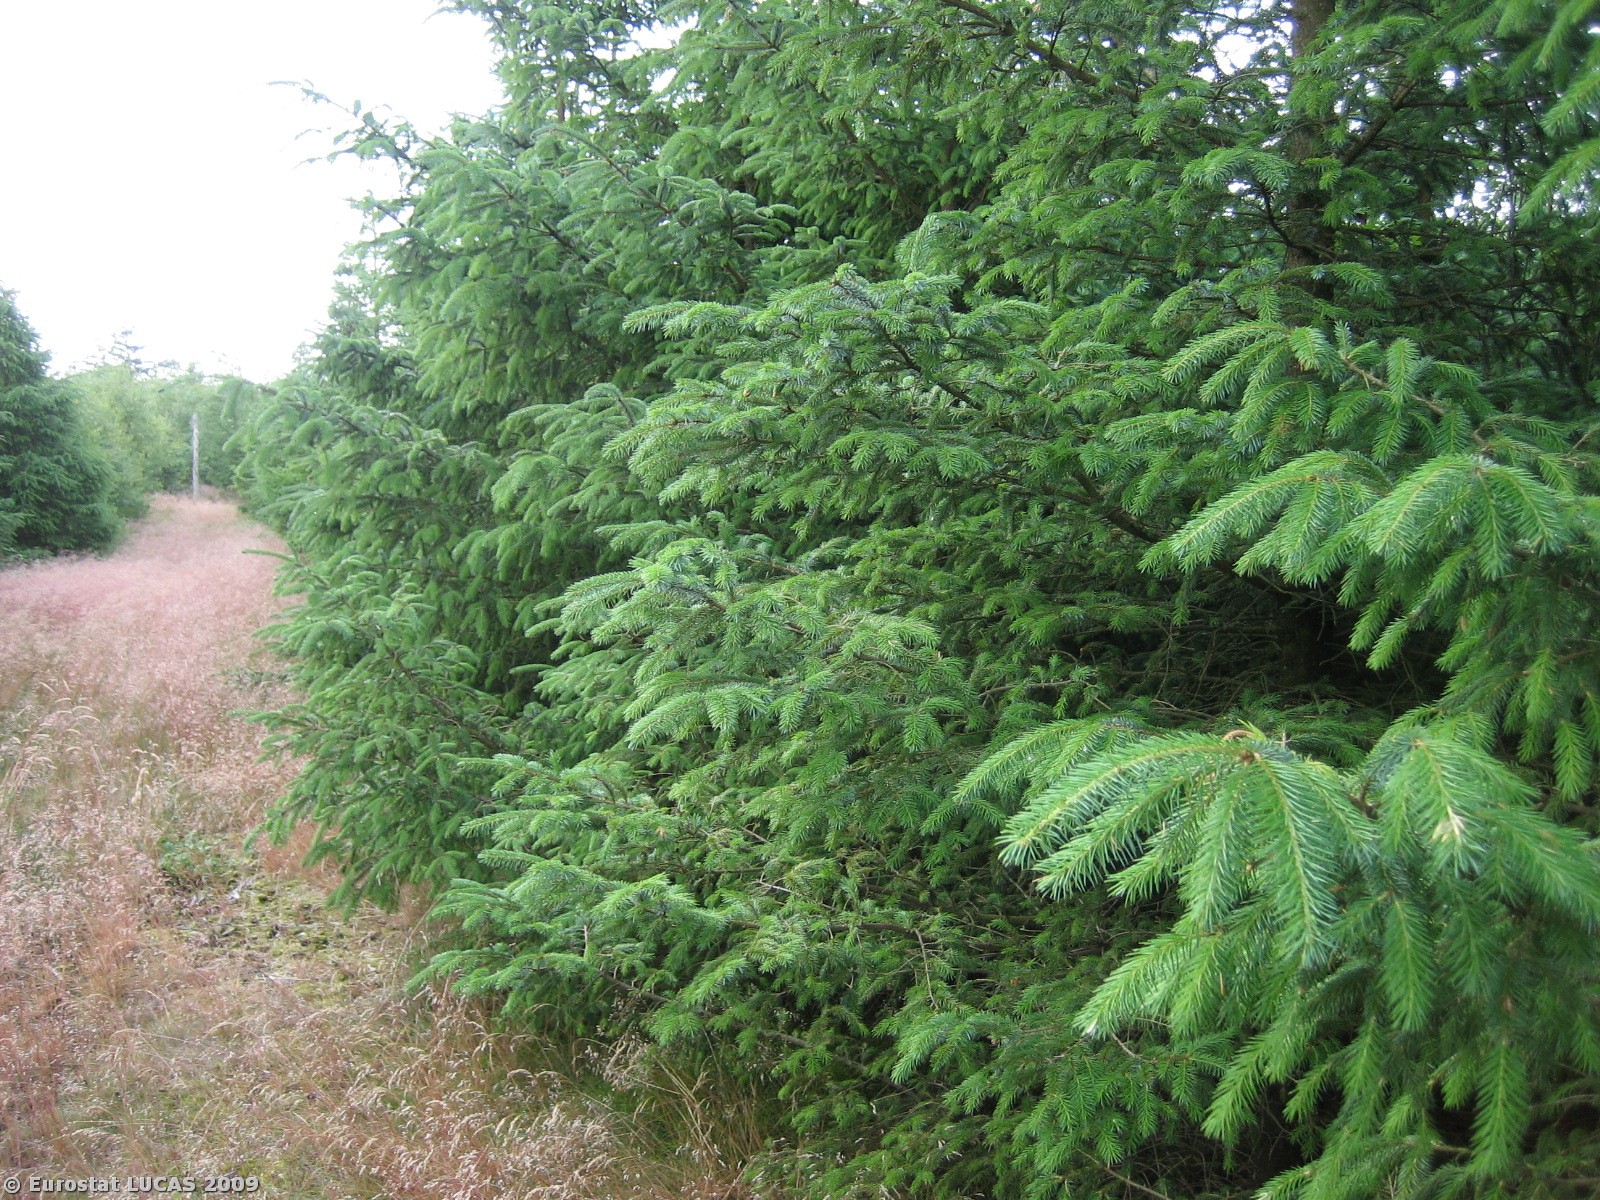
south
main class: Woodland
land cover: Coniferous woodland
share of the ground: > 75 %
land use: Forestry
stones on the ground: < 10 %
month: July
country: DK
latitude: 55.5653
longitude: 8.3048
